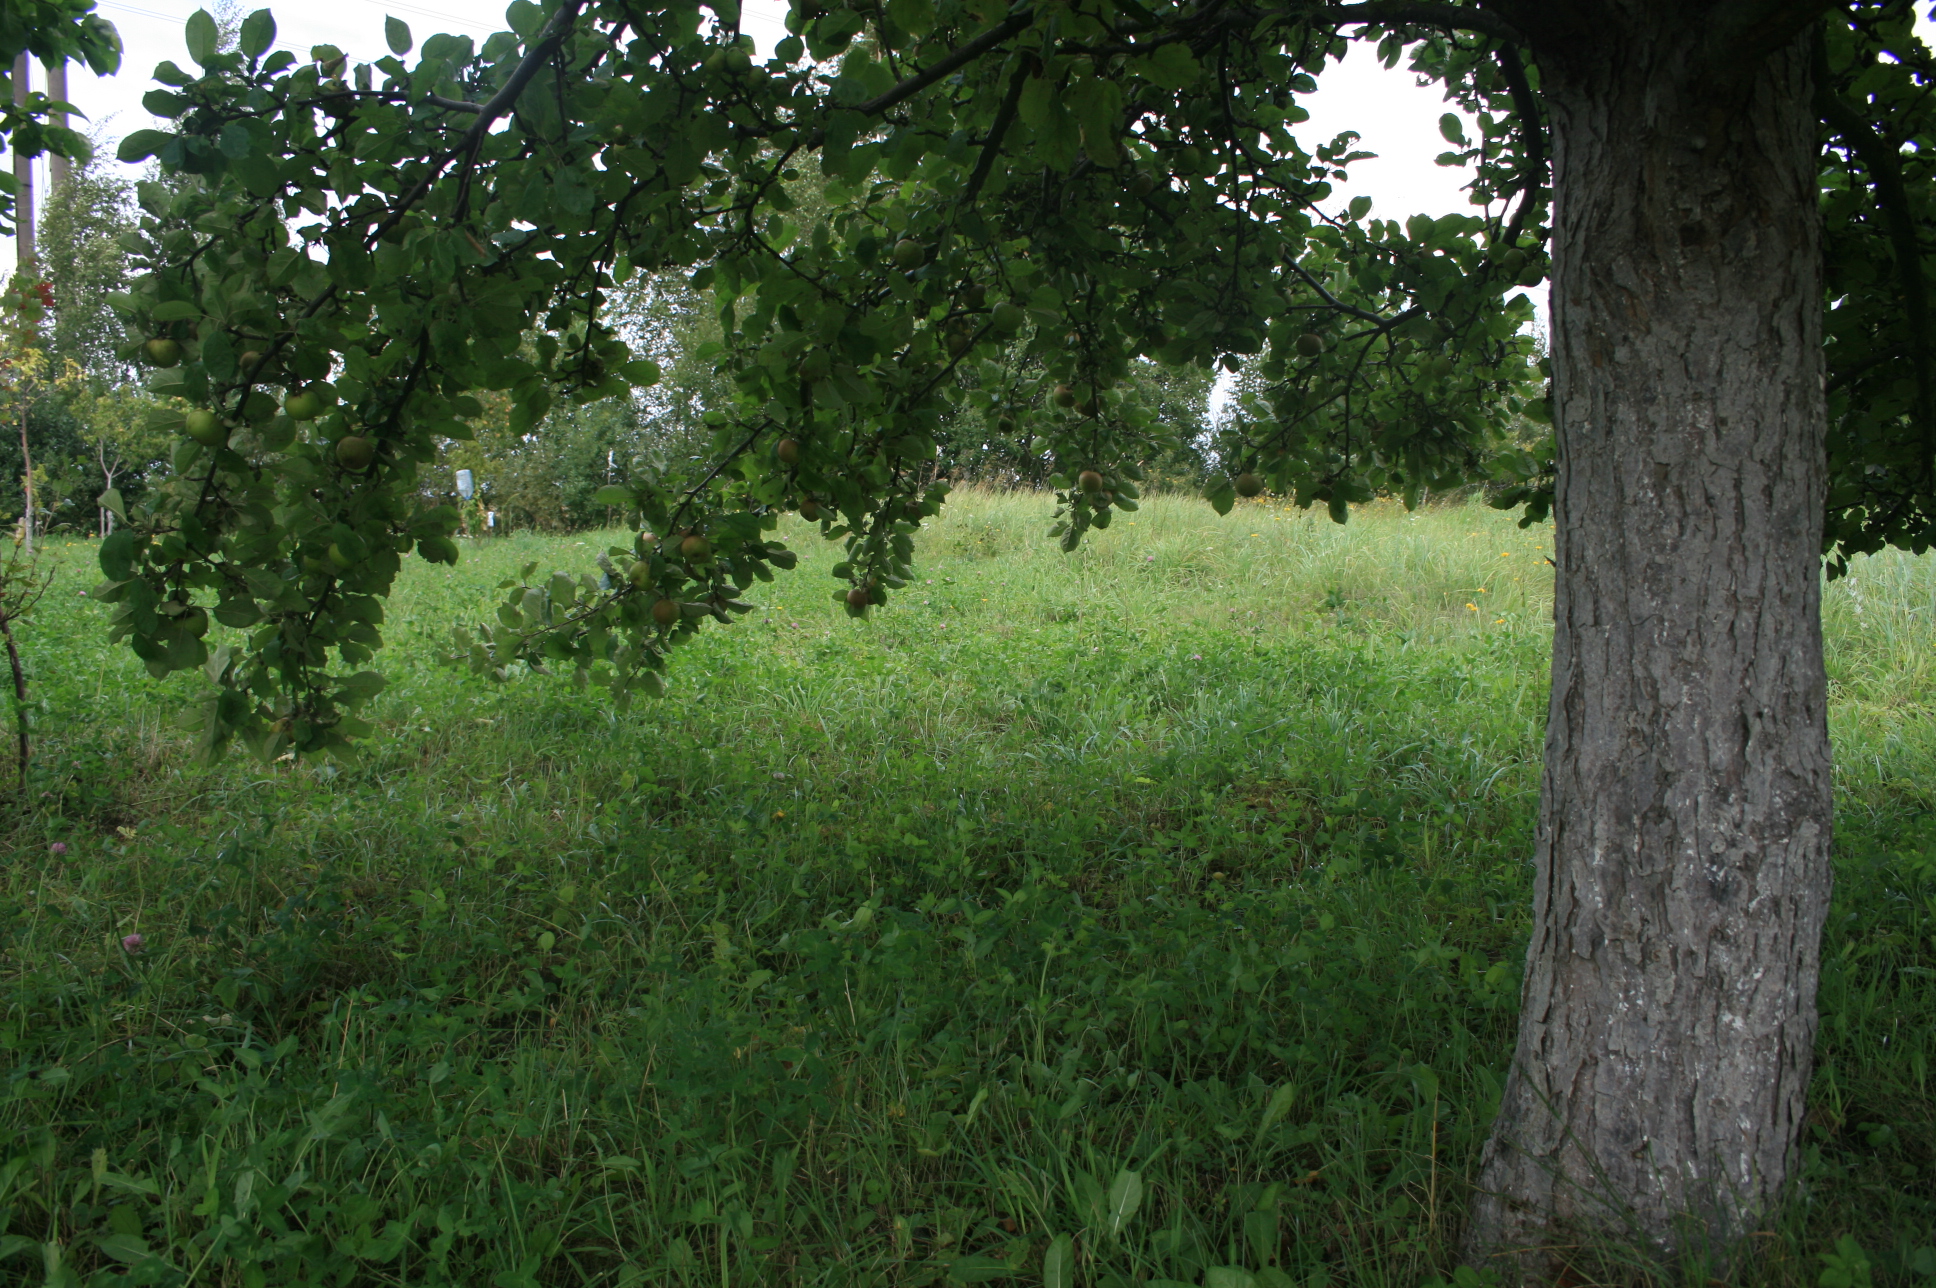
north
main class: Cropland
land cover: Apple fruit
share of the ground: 50 - 75 %
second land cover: Grassland without tree/shrub cover
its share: > 75 %
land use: Kitchen garden
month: September
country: LT
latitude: 55.7028
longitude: 21.3249
